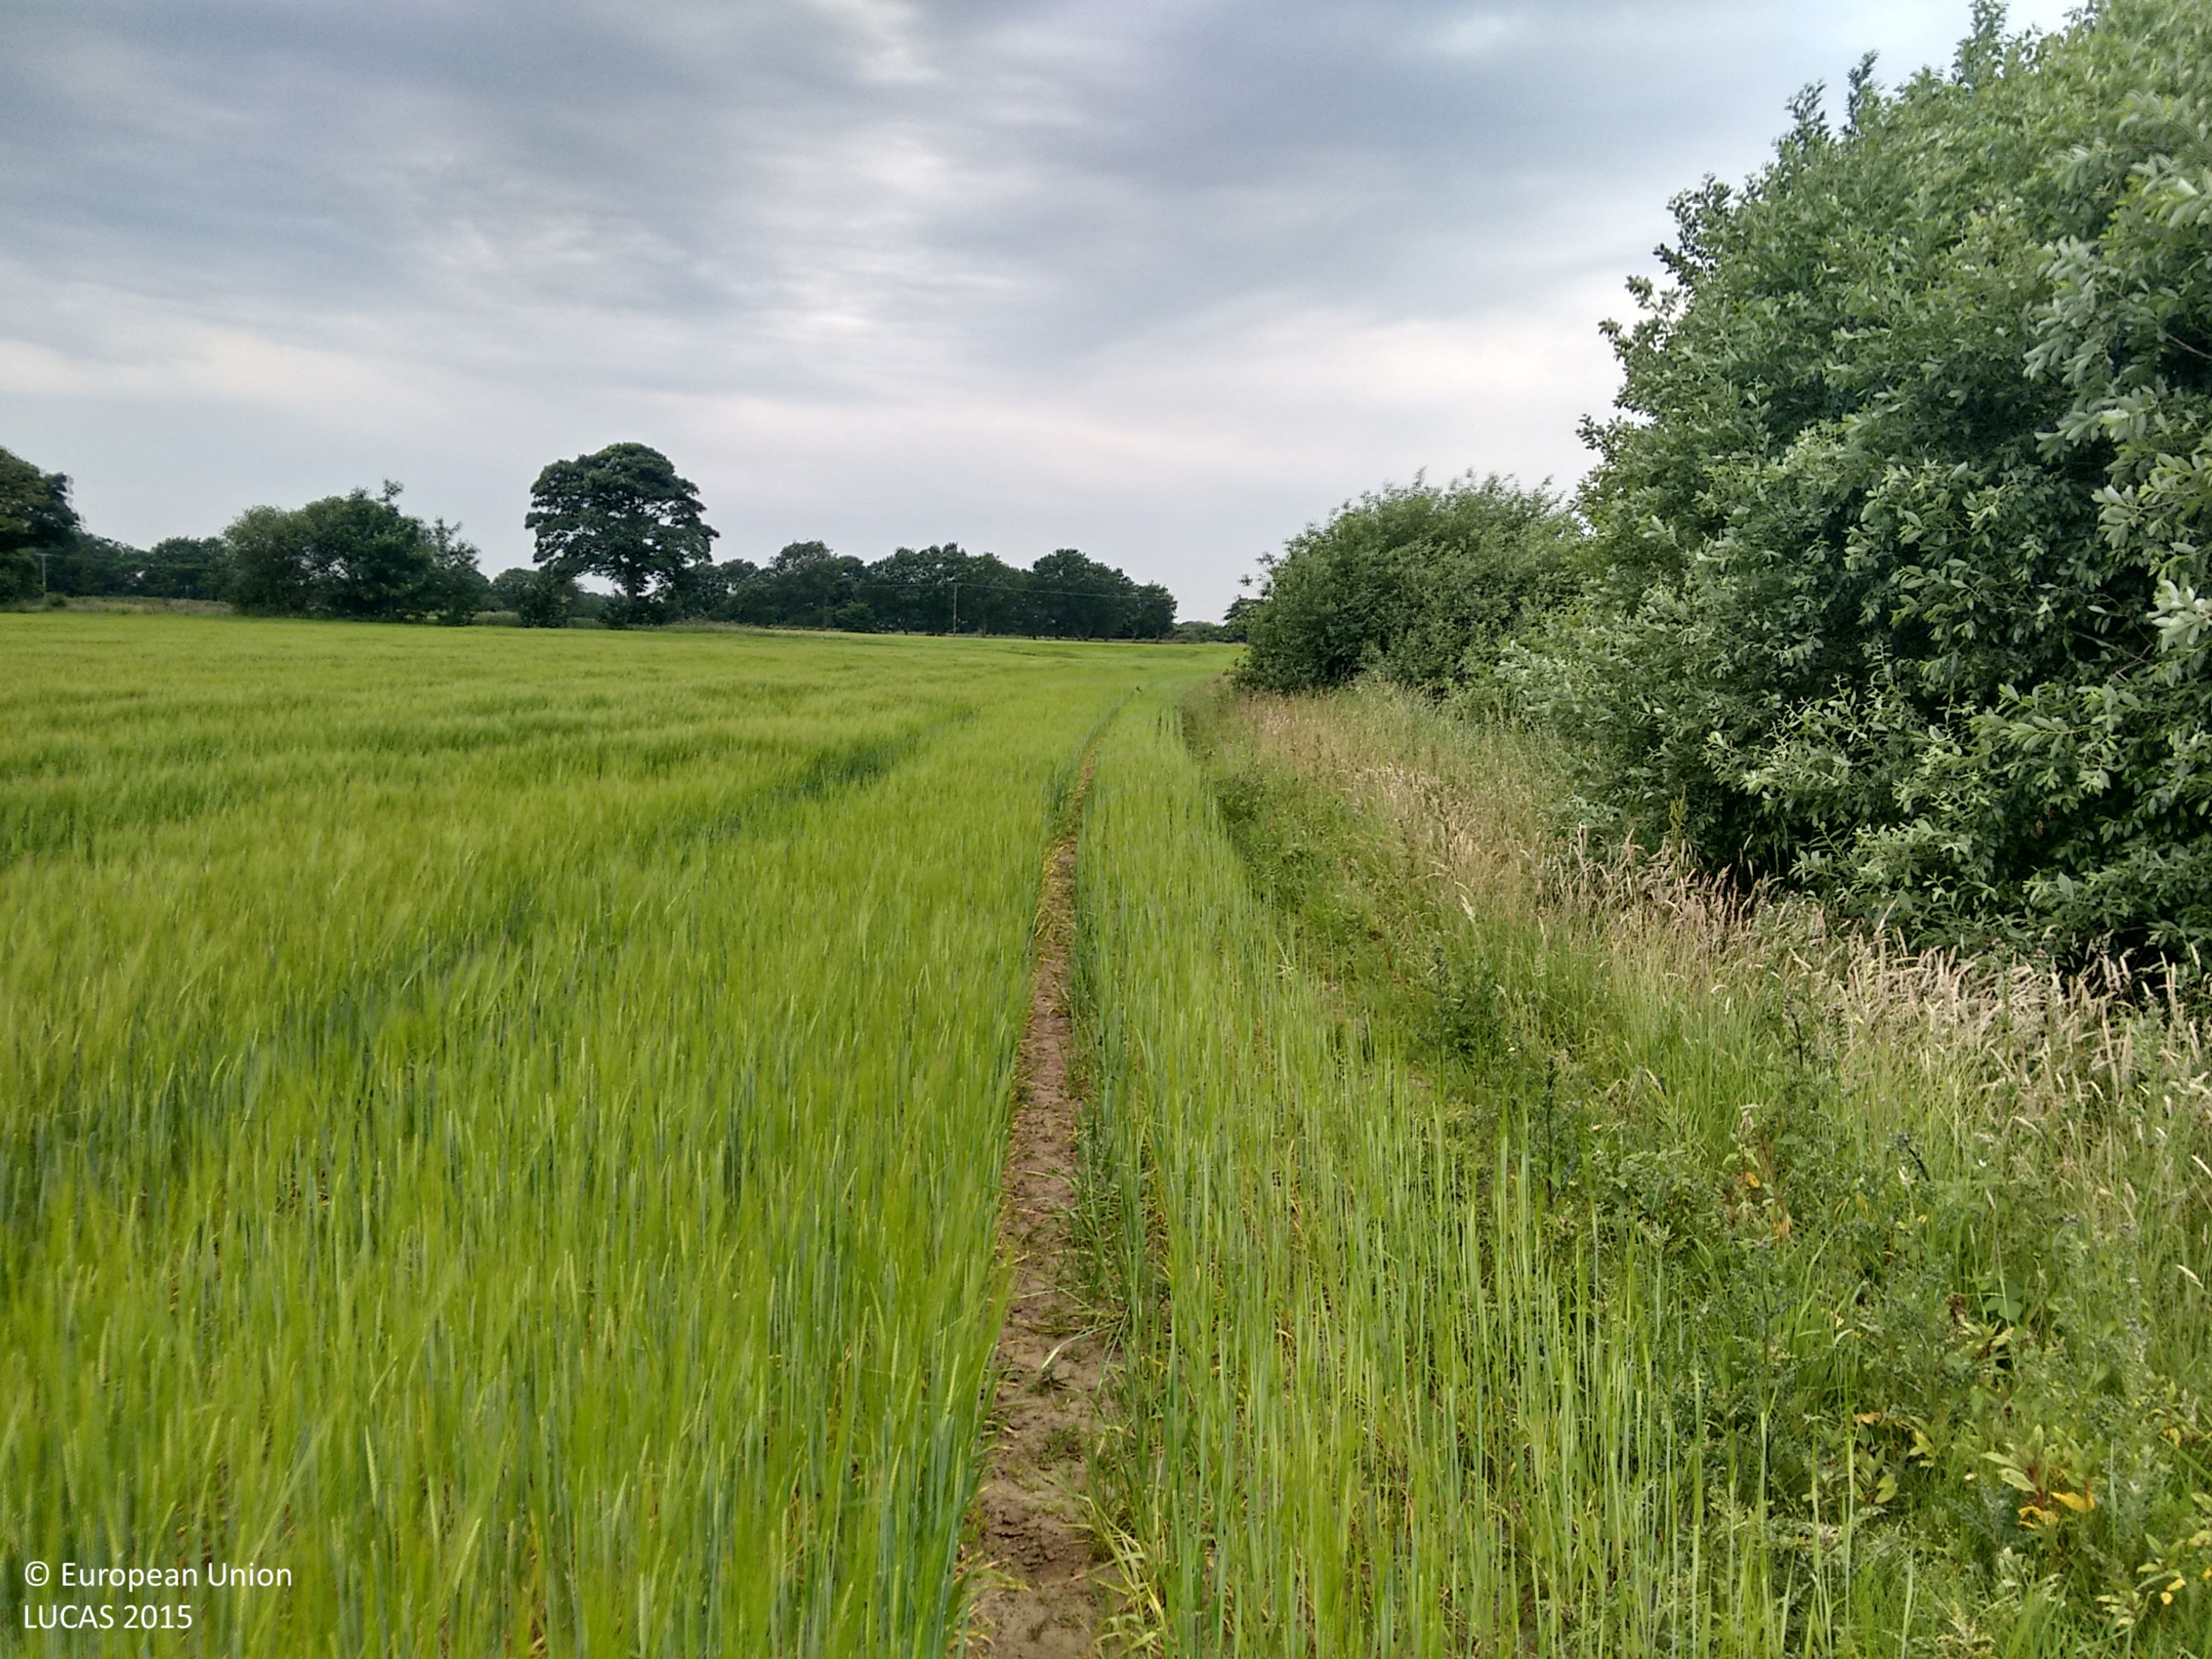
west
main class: Cropland
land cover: Barley
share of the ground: > 75 %
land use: Agriculture (excluding fallow land and kitchen gardens)
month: July
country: GB
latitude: 53.4826
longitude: -2.4670
